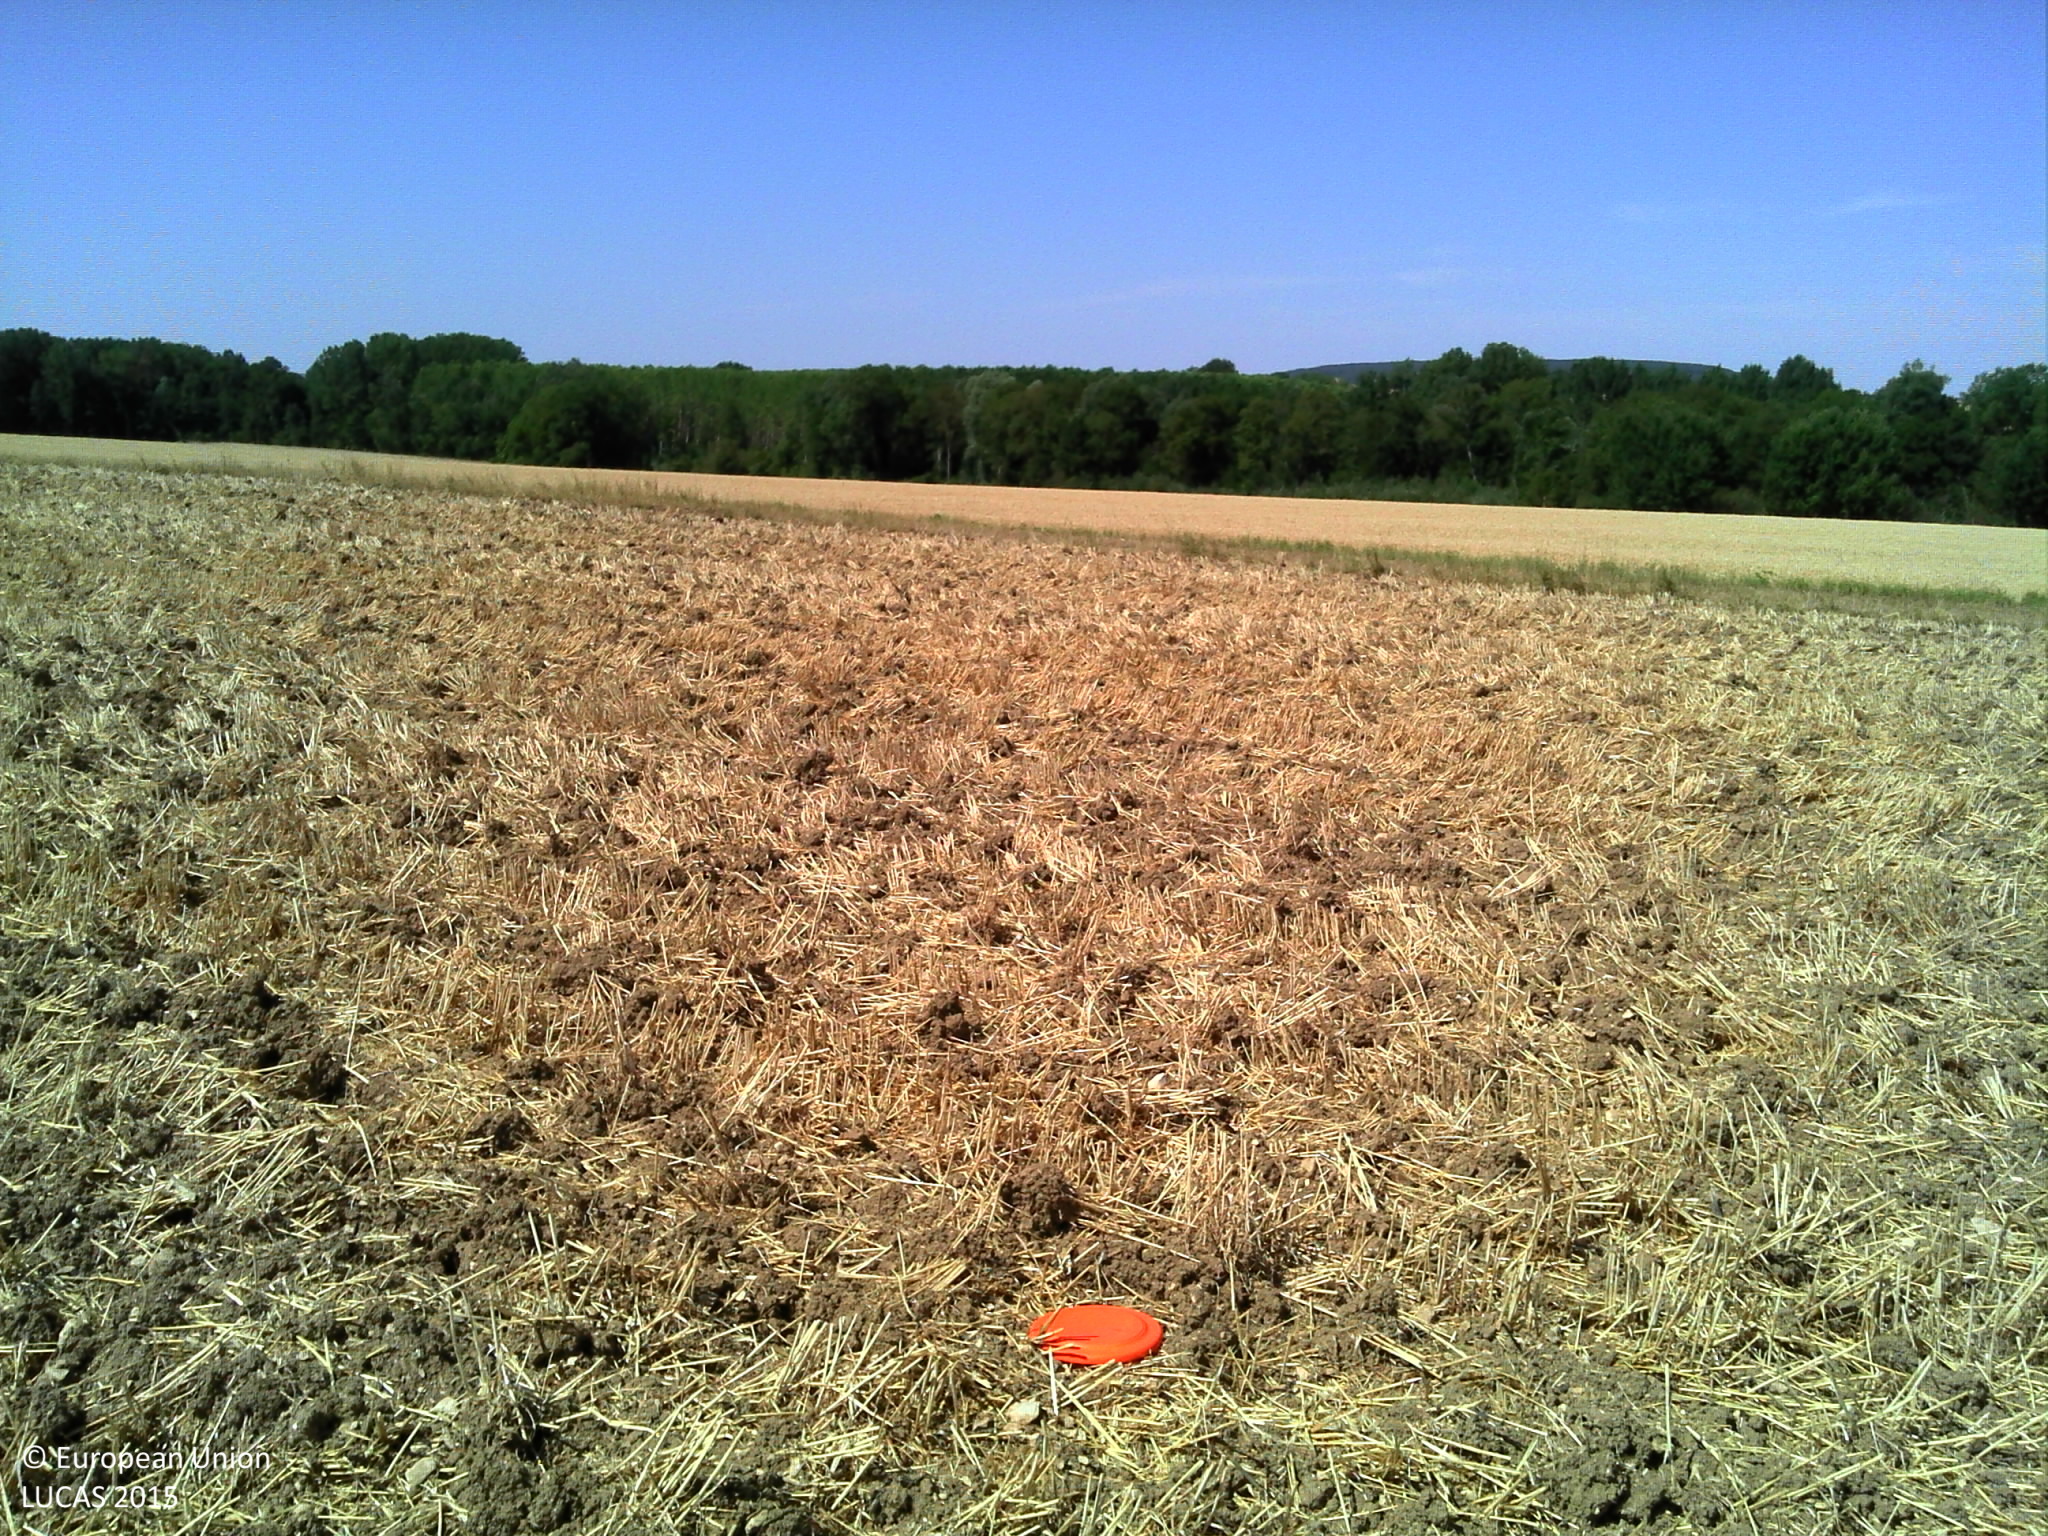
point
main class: Cropland
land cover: Common wheat
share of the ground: > 75 %
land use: Agriculture (excluding fallow land and kitchen gardens)
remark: Tilled/Sowed
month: August
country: FR
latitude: 47.9384
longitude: 3.4488
